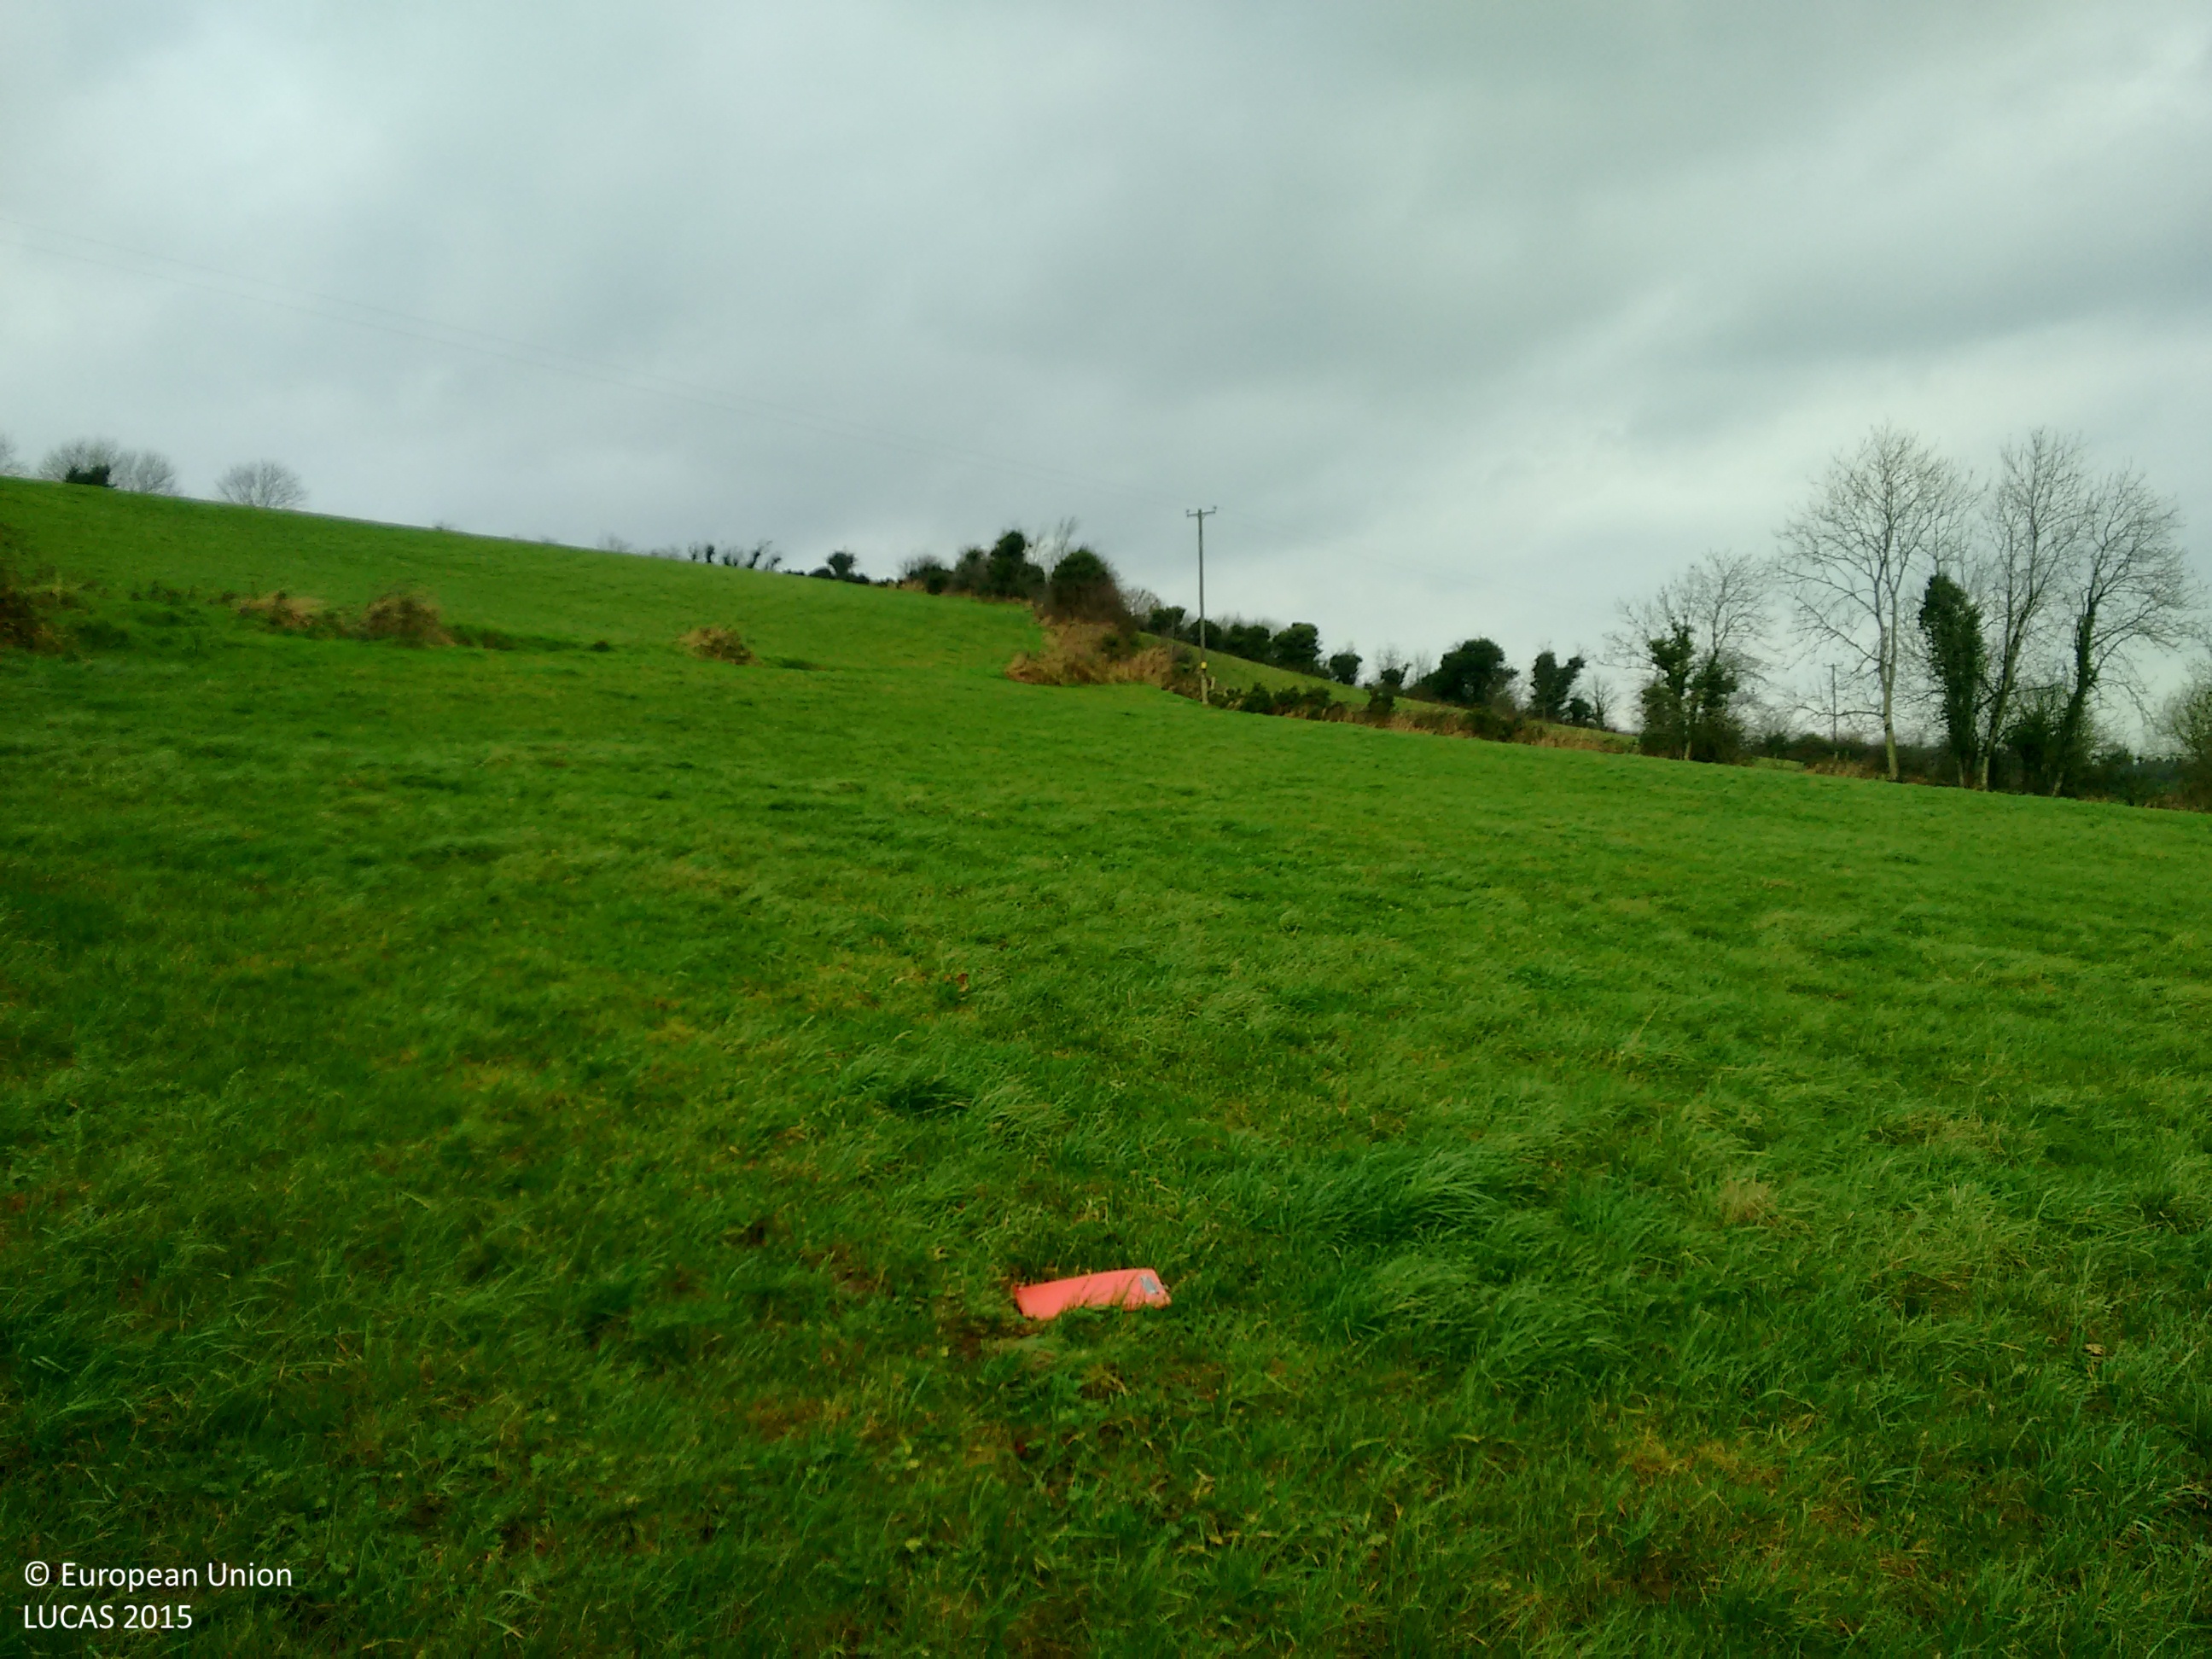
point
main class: Grassland
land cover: Grassland without tree/shrub cover
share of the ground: > 75 %
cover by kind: herbaceous plants 95 %, unconsolidated bare surface 5 %
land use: Agriculture (excluding fallow land and kitchen gardens)
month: December
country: IE
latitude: 54.0877
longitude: -7.2243
